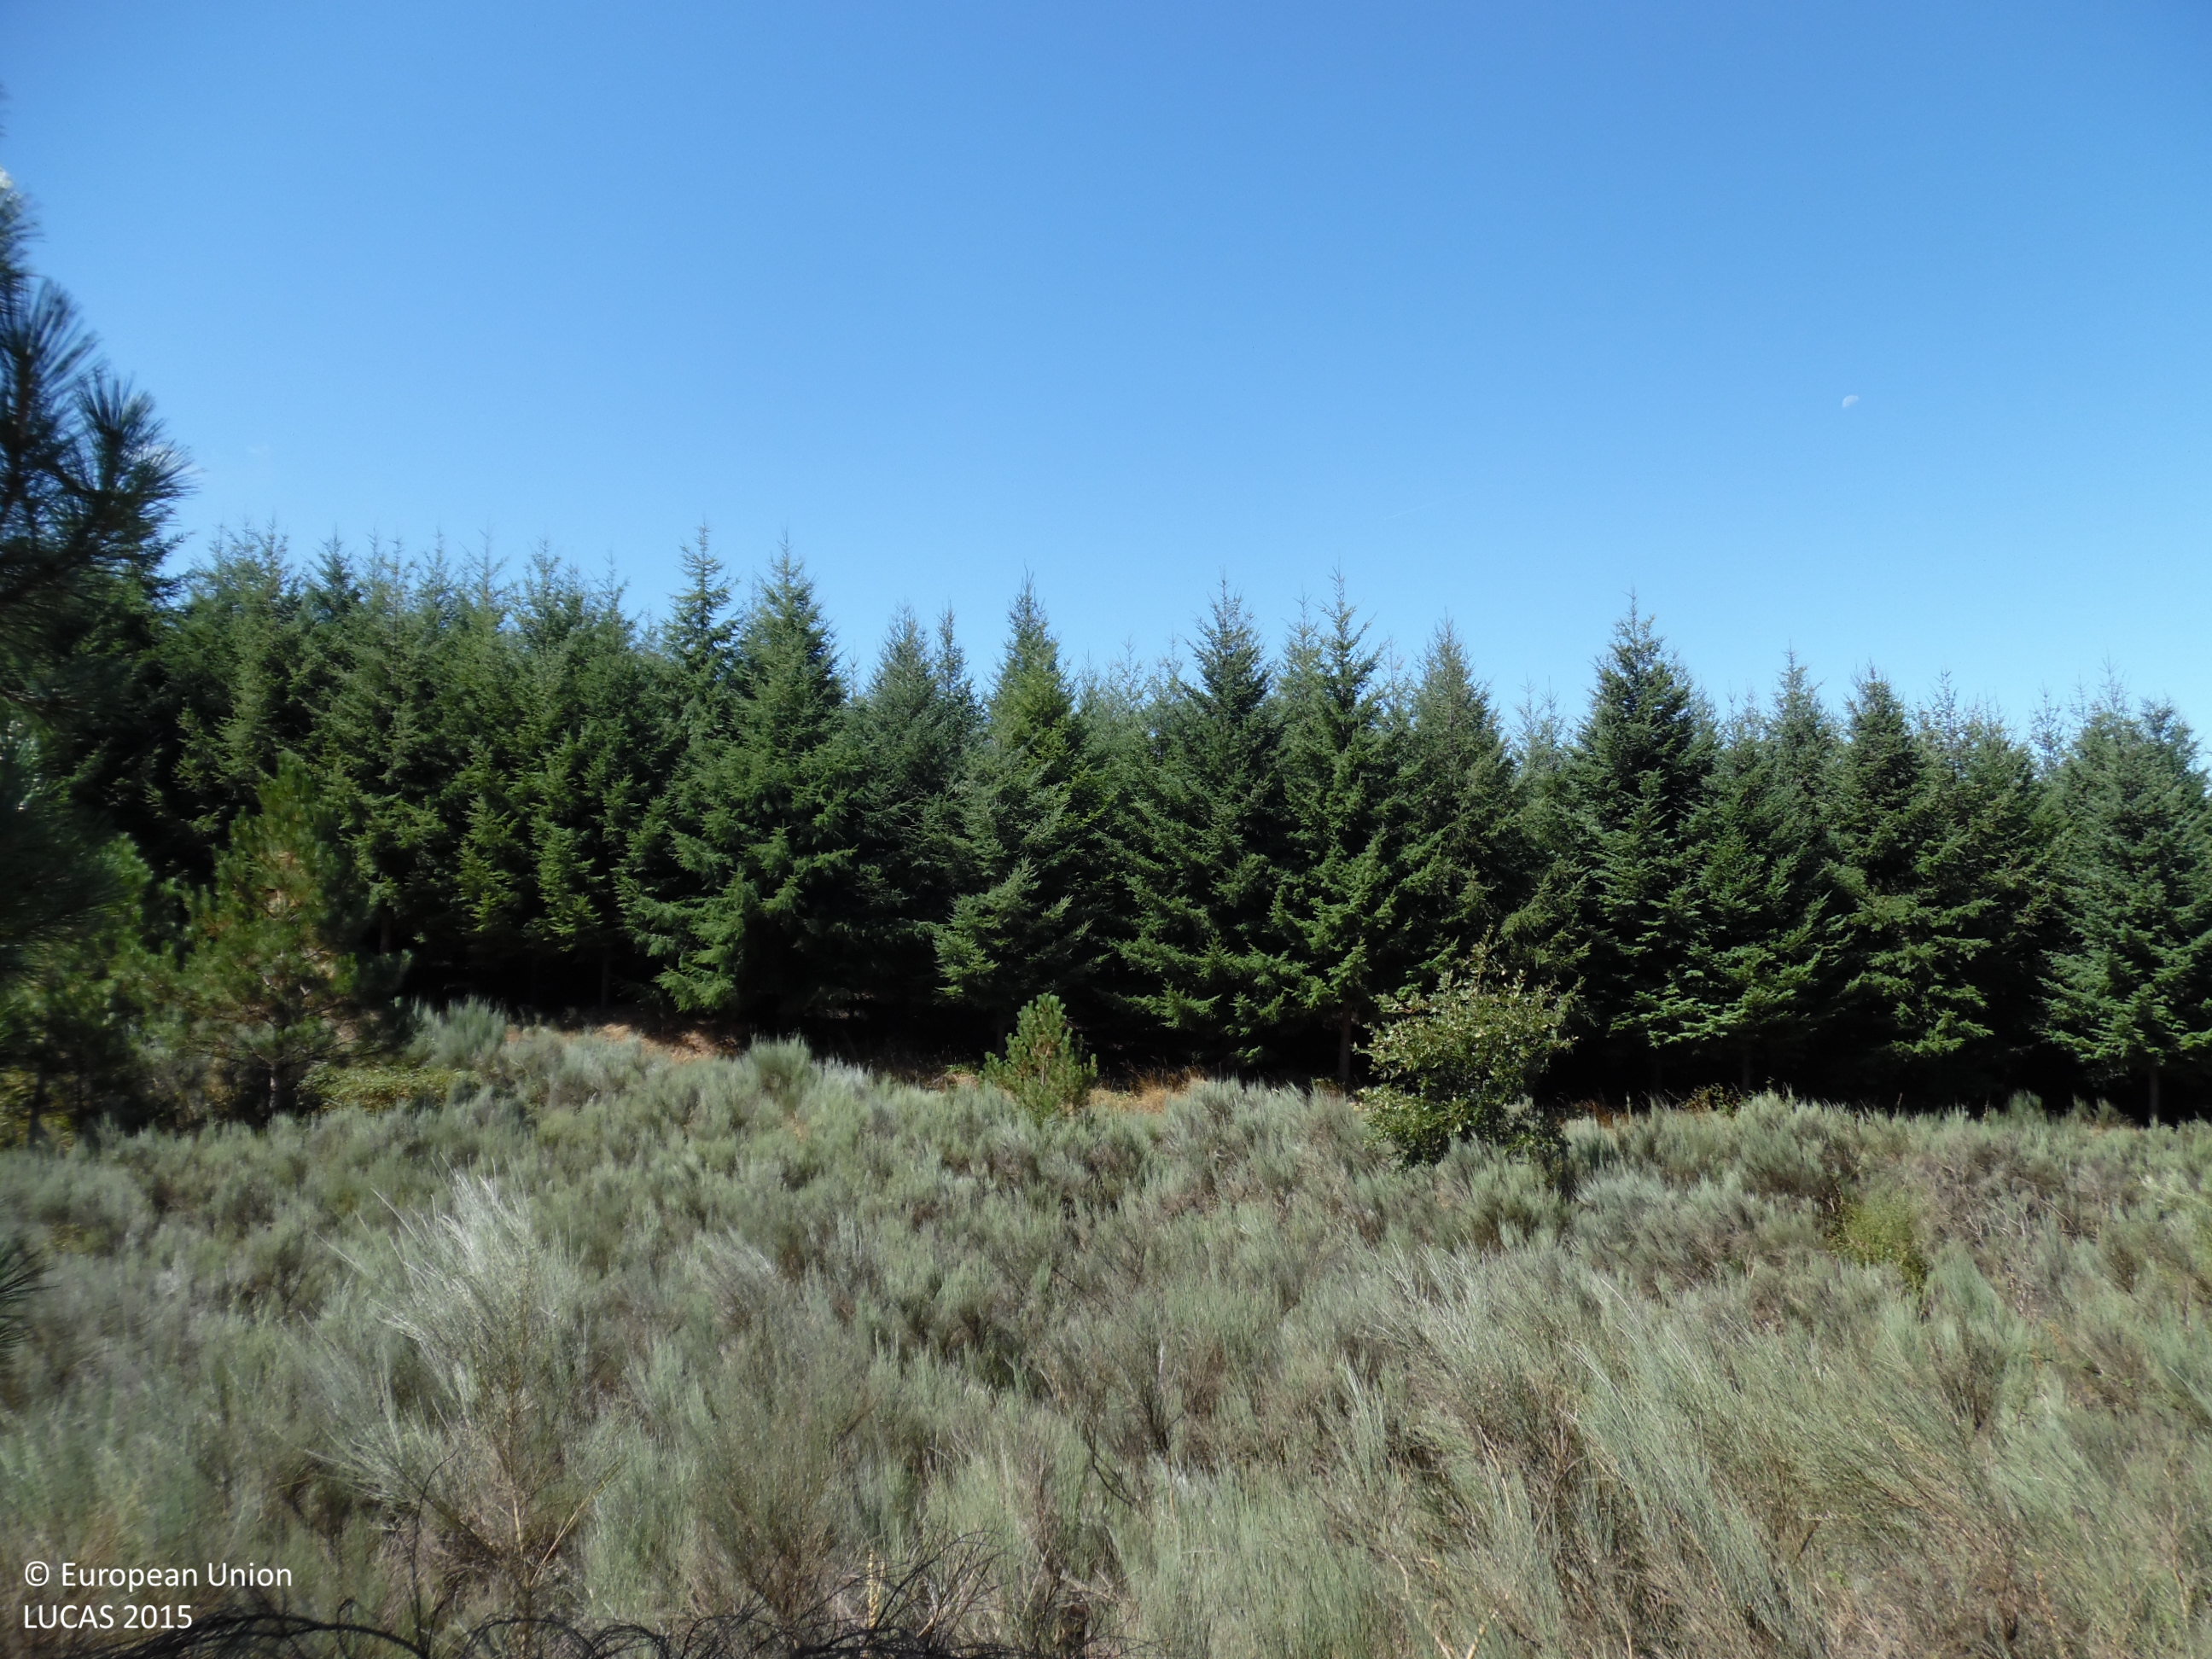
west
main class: Shrubland
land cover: Shrubland with sparse tree cover
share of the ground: > 75 %
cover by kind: shrubs 95 %, coniferous forest trees 5 %
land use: Abandoned areas
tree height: < 5 m
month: August
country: ES
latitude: 42.6802
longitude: -6.4337
